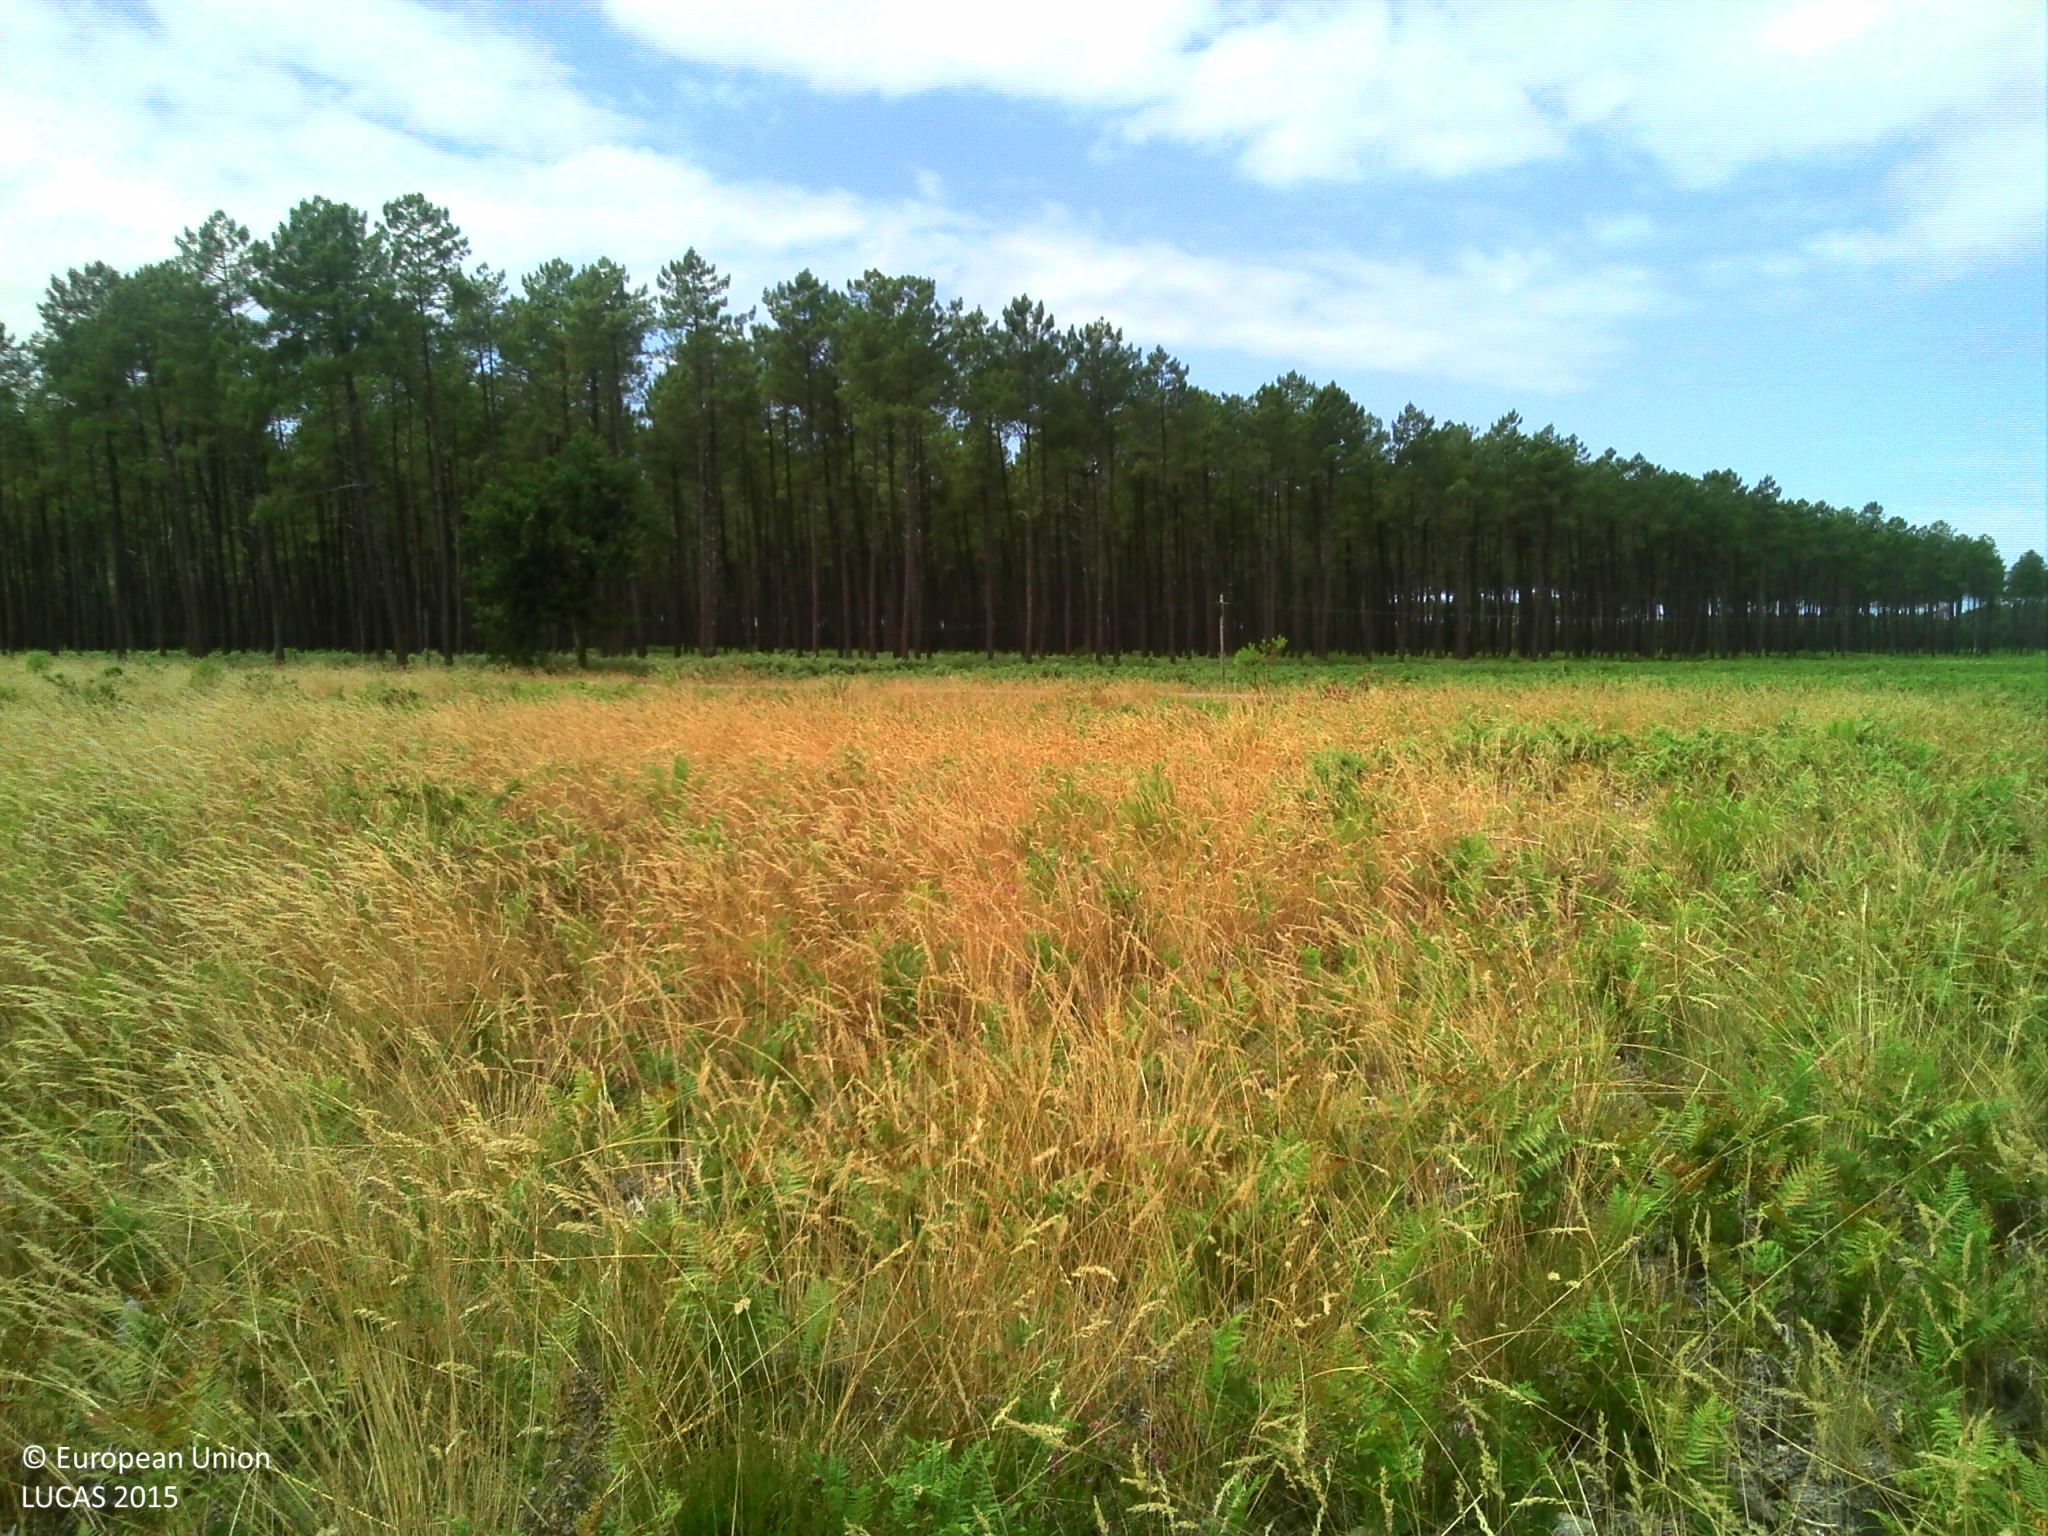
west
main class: Grassland
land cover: Grassland with sparse tree/shrub cover
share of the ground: > 75 %
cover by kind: herbaceous plants 85 %, broadleaved forest trees 5 %, shrubs 5 %, unconsolidated bare surface 5 %
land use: Forestry
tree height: < 5 m
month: July
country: FR
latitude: 43.9581
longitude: -1.2226
